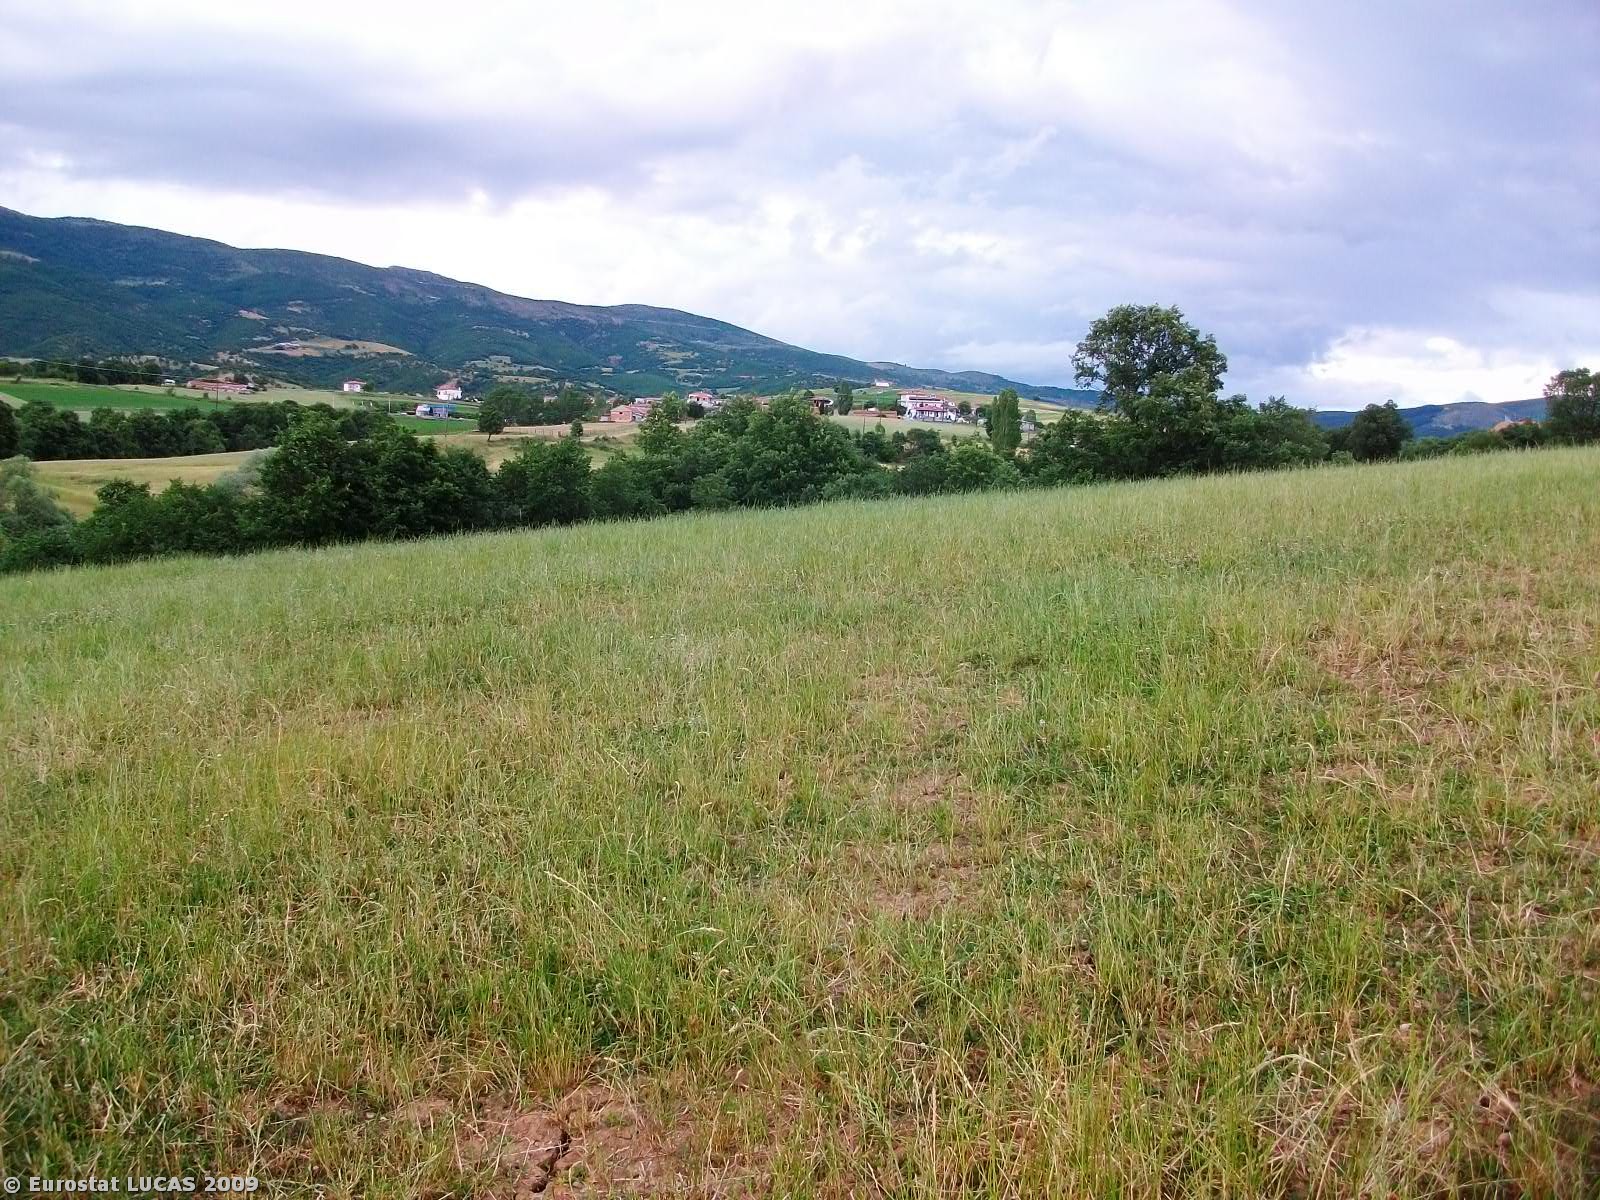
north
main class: Grassland
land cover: Spontaneously vegetated surfaces
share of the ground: > 75 %
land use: Fallow land
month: June
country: GR
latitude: 39.9038
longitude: 21.7660
